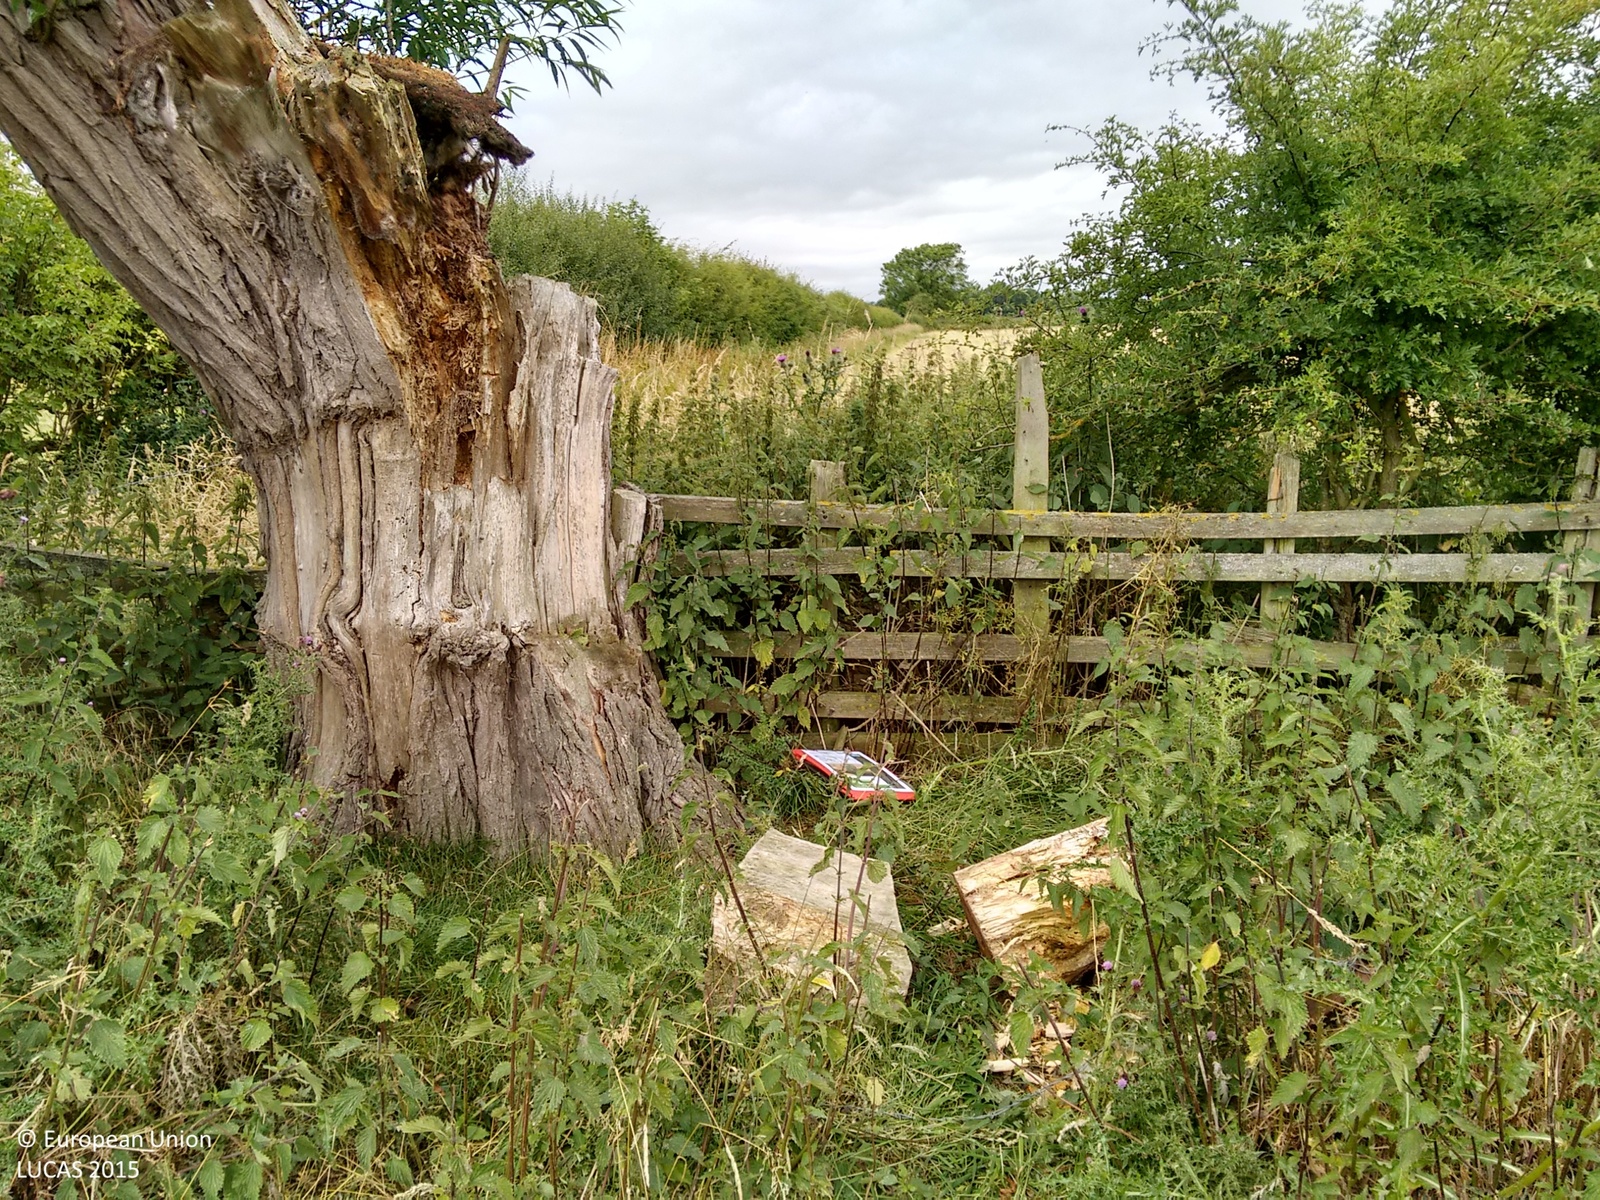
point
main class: Grassland
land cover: Grassland without tree/shrub cover
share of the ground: > 75 %
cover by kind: herbaceous plants 100 %
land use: Agriculture (excluding fallow land and kitchen gardens)
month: July
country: GB
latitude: 52.5062
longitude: -0.9309
